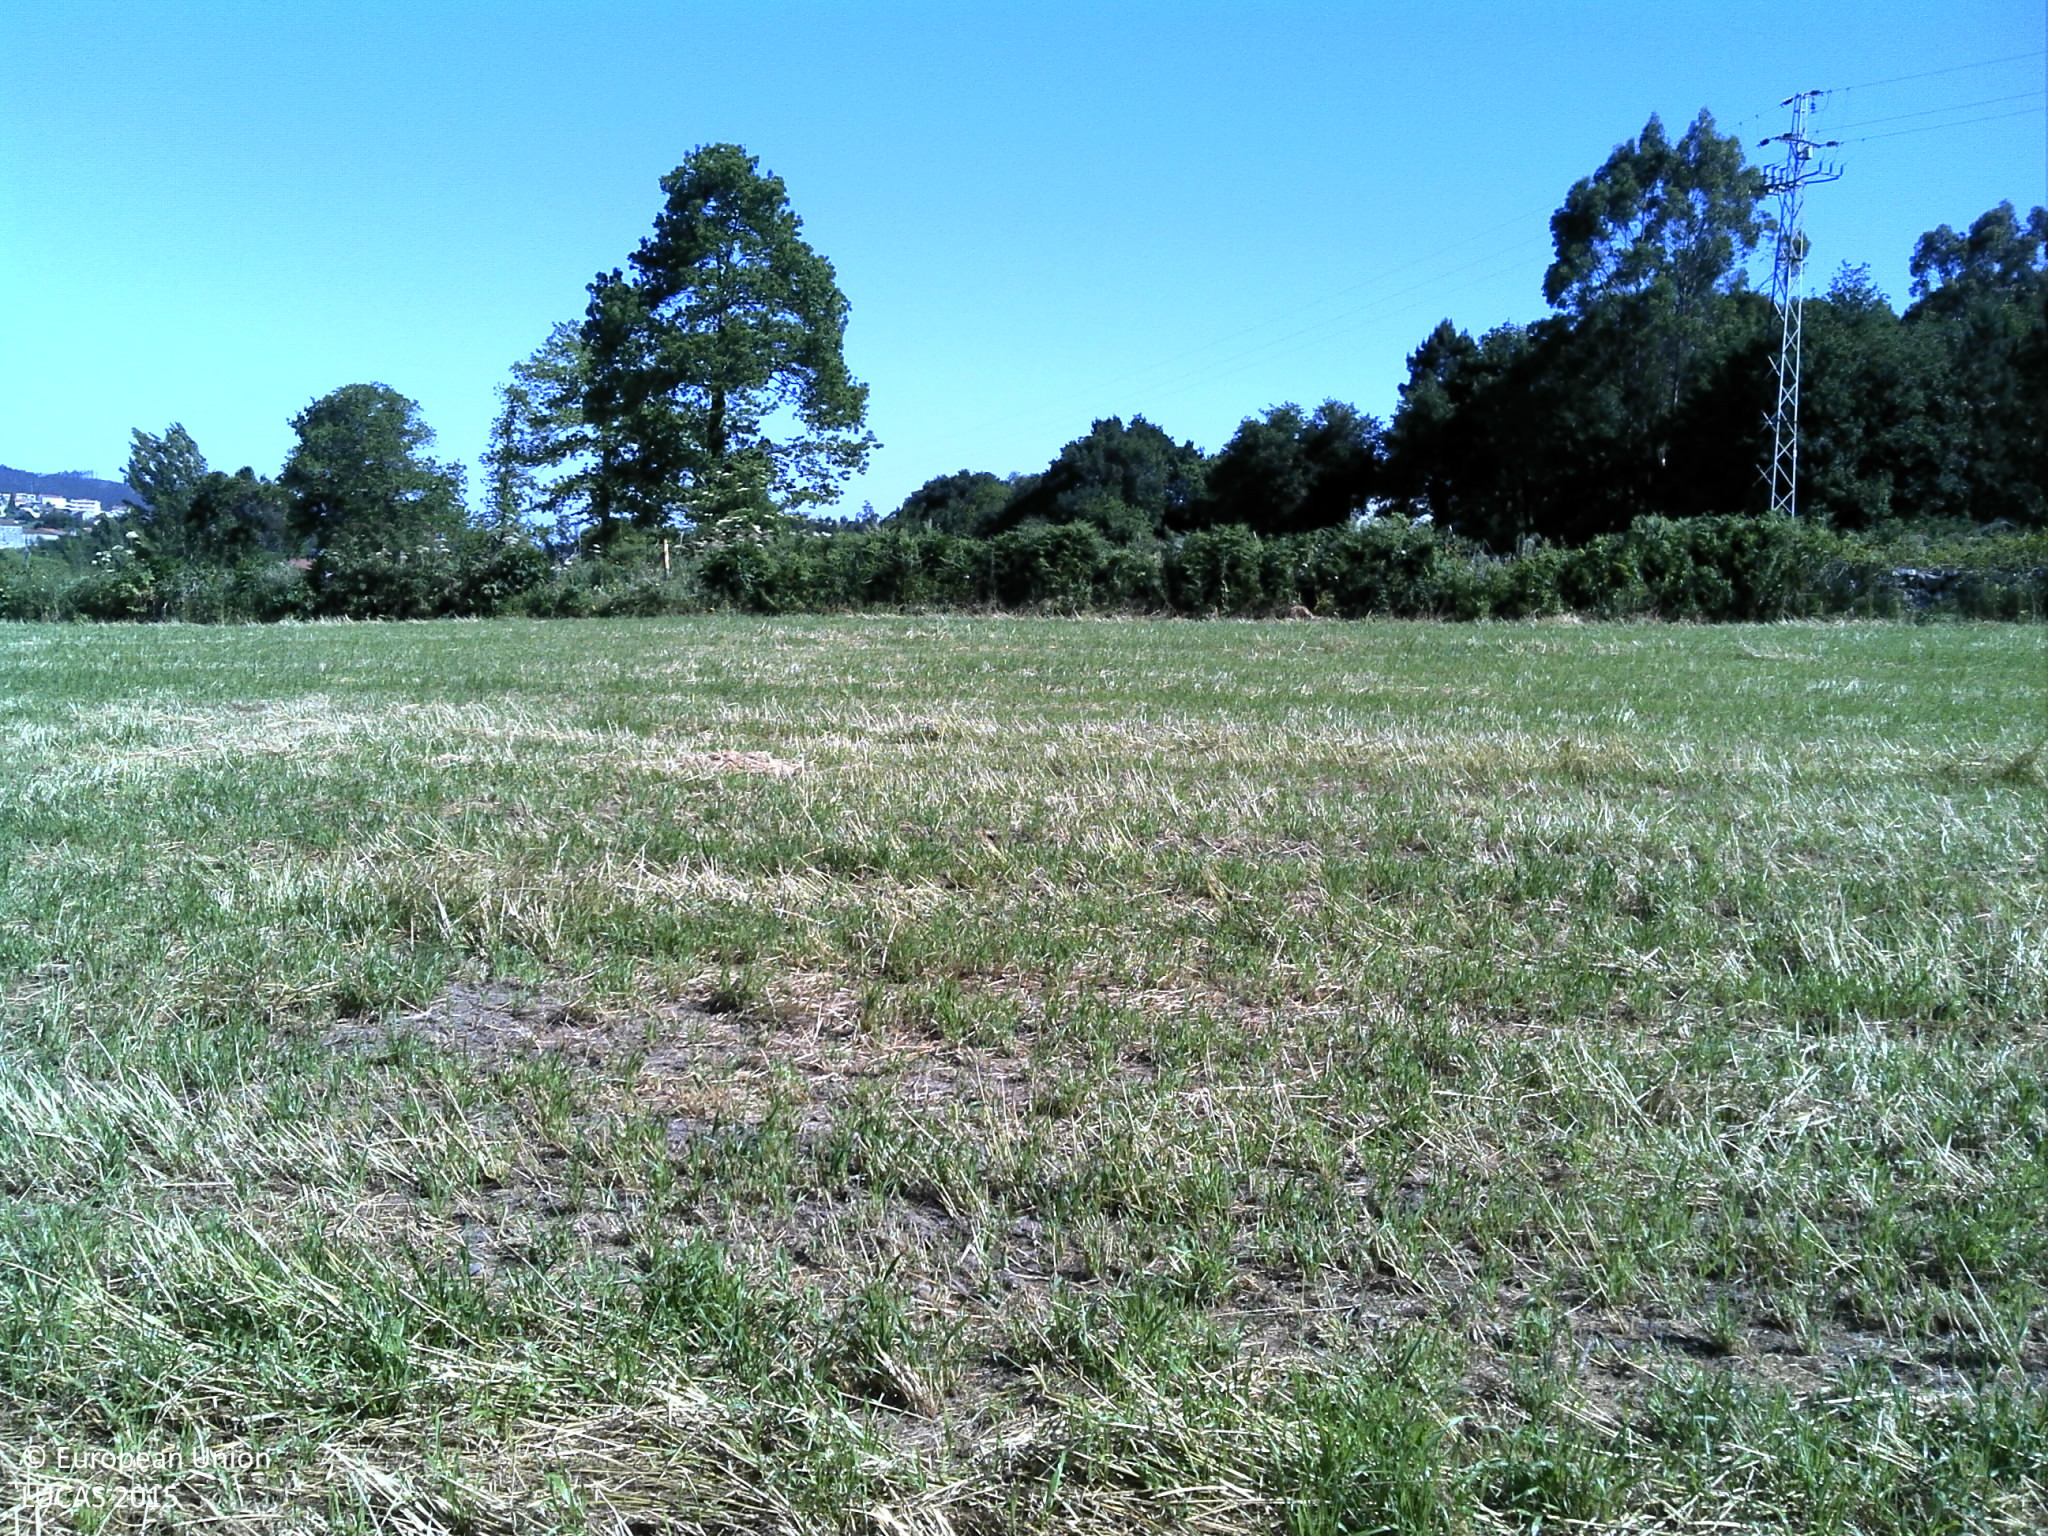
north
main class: Cropland
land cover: Temporary grasslands
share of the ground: 25 - 50 %
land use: Agriculture (excluding fallow land and kitchen gardens)
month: May
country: PT
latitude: 41.3000
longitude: -8.6067
